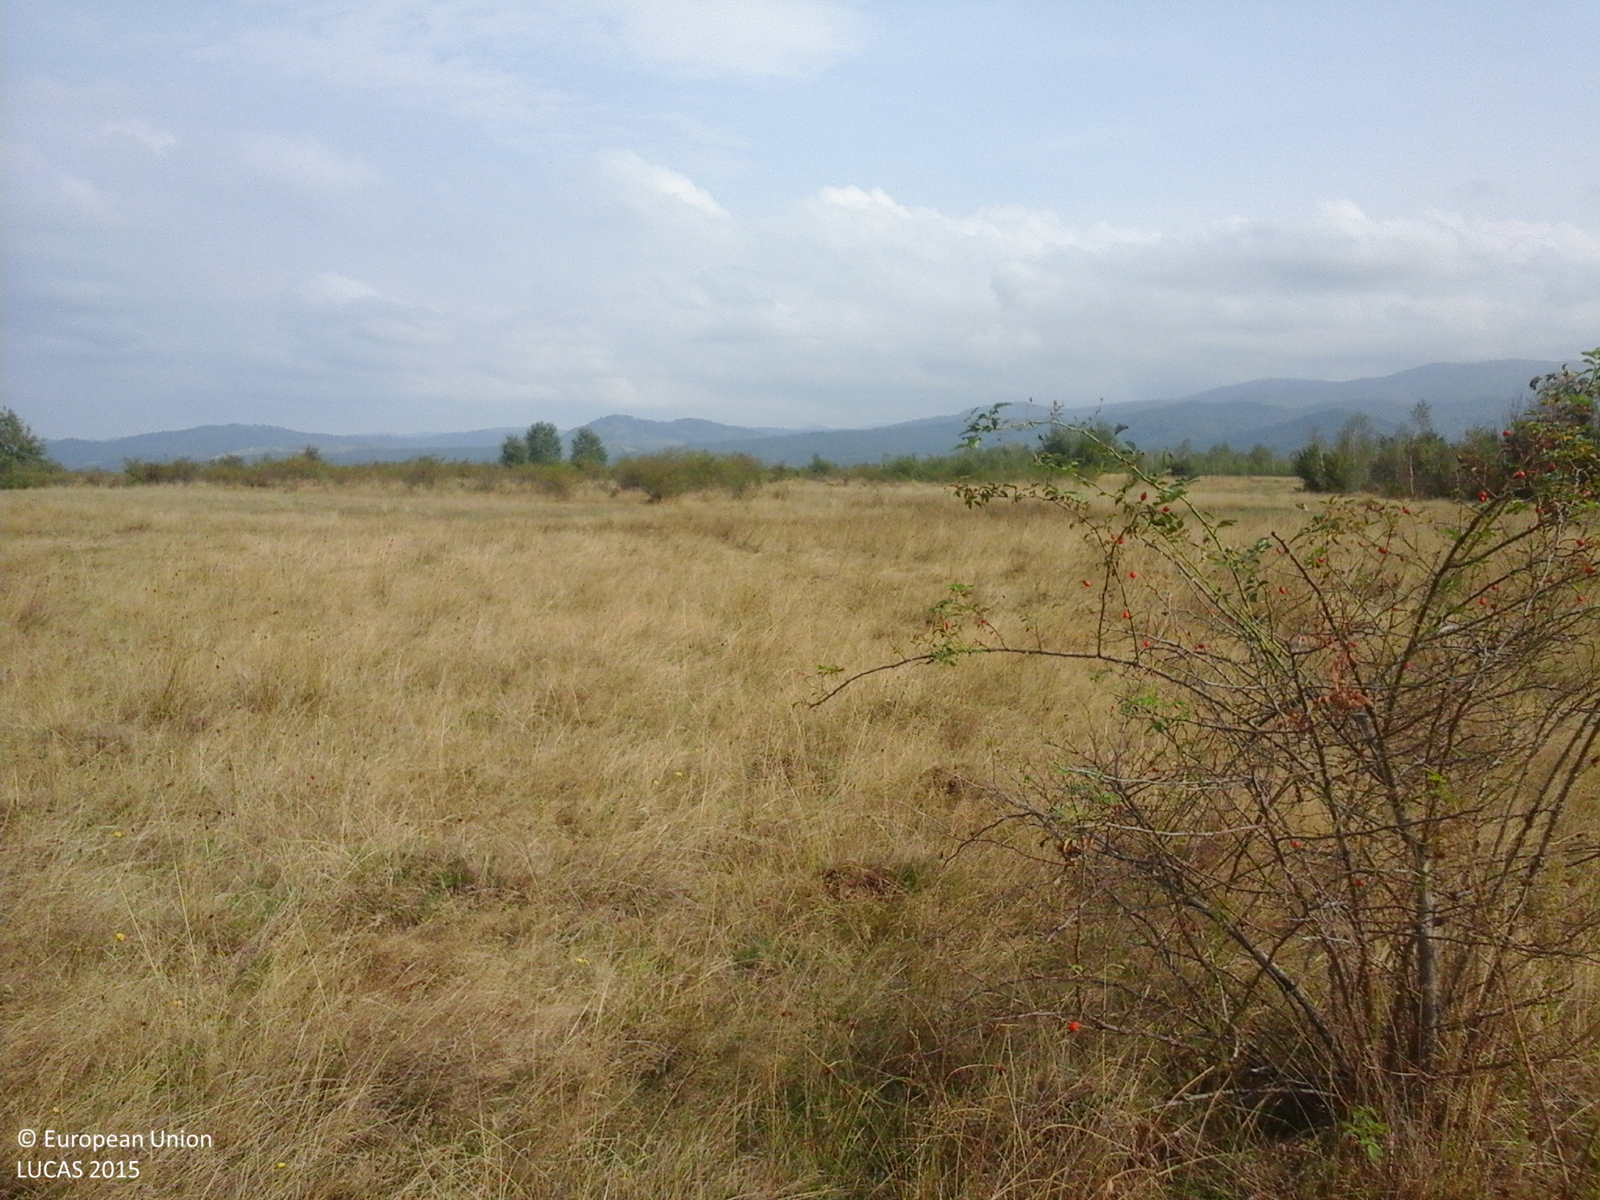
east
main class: Grassland
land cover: Grassland with sparse tree/shrub cover
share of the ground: > 75 %
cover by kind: herbaceous plants 85 %, shrubs 10 %, broadleaved forest trees 5 %
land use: Agriculture (excluding fallow land and kitchen gardens)
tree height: < 5 m
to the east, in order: Grassland with sparse tree/shrub cover; Tracks; Grassland without tree/shrub cover; Grassland with sparse tree/shrub cover; Grassland without tree/shrub cover; Grassland with sparse tree/shrub cover
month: September
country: RO
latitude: 45.8044
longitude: 22.2809
